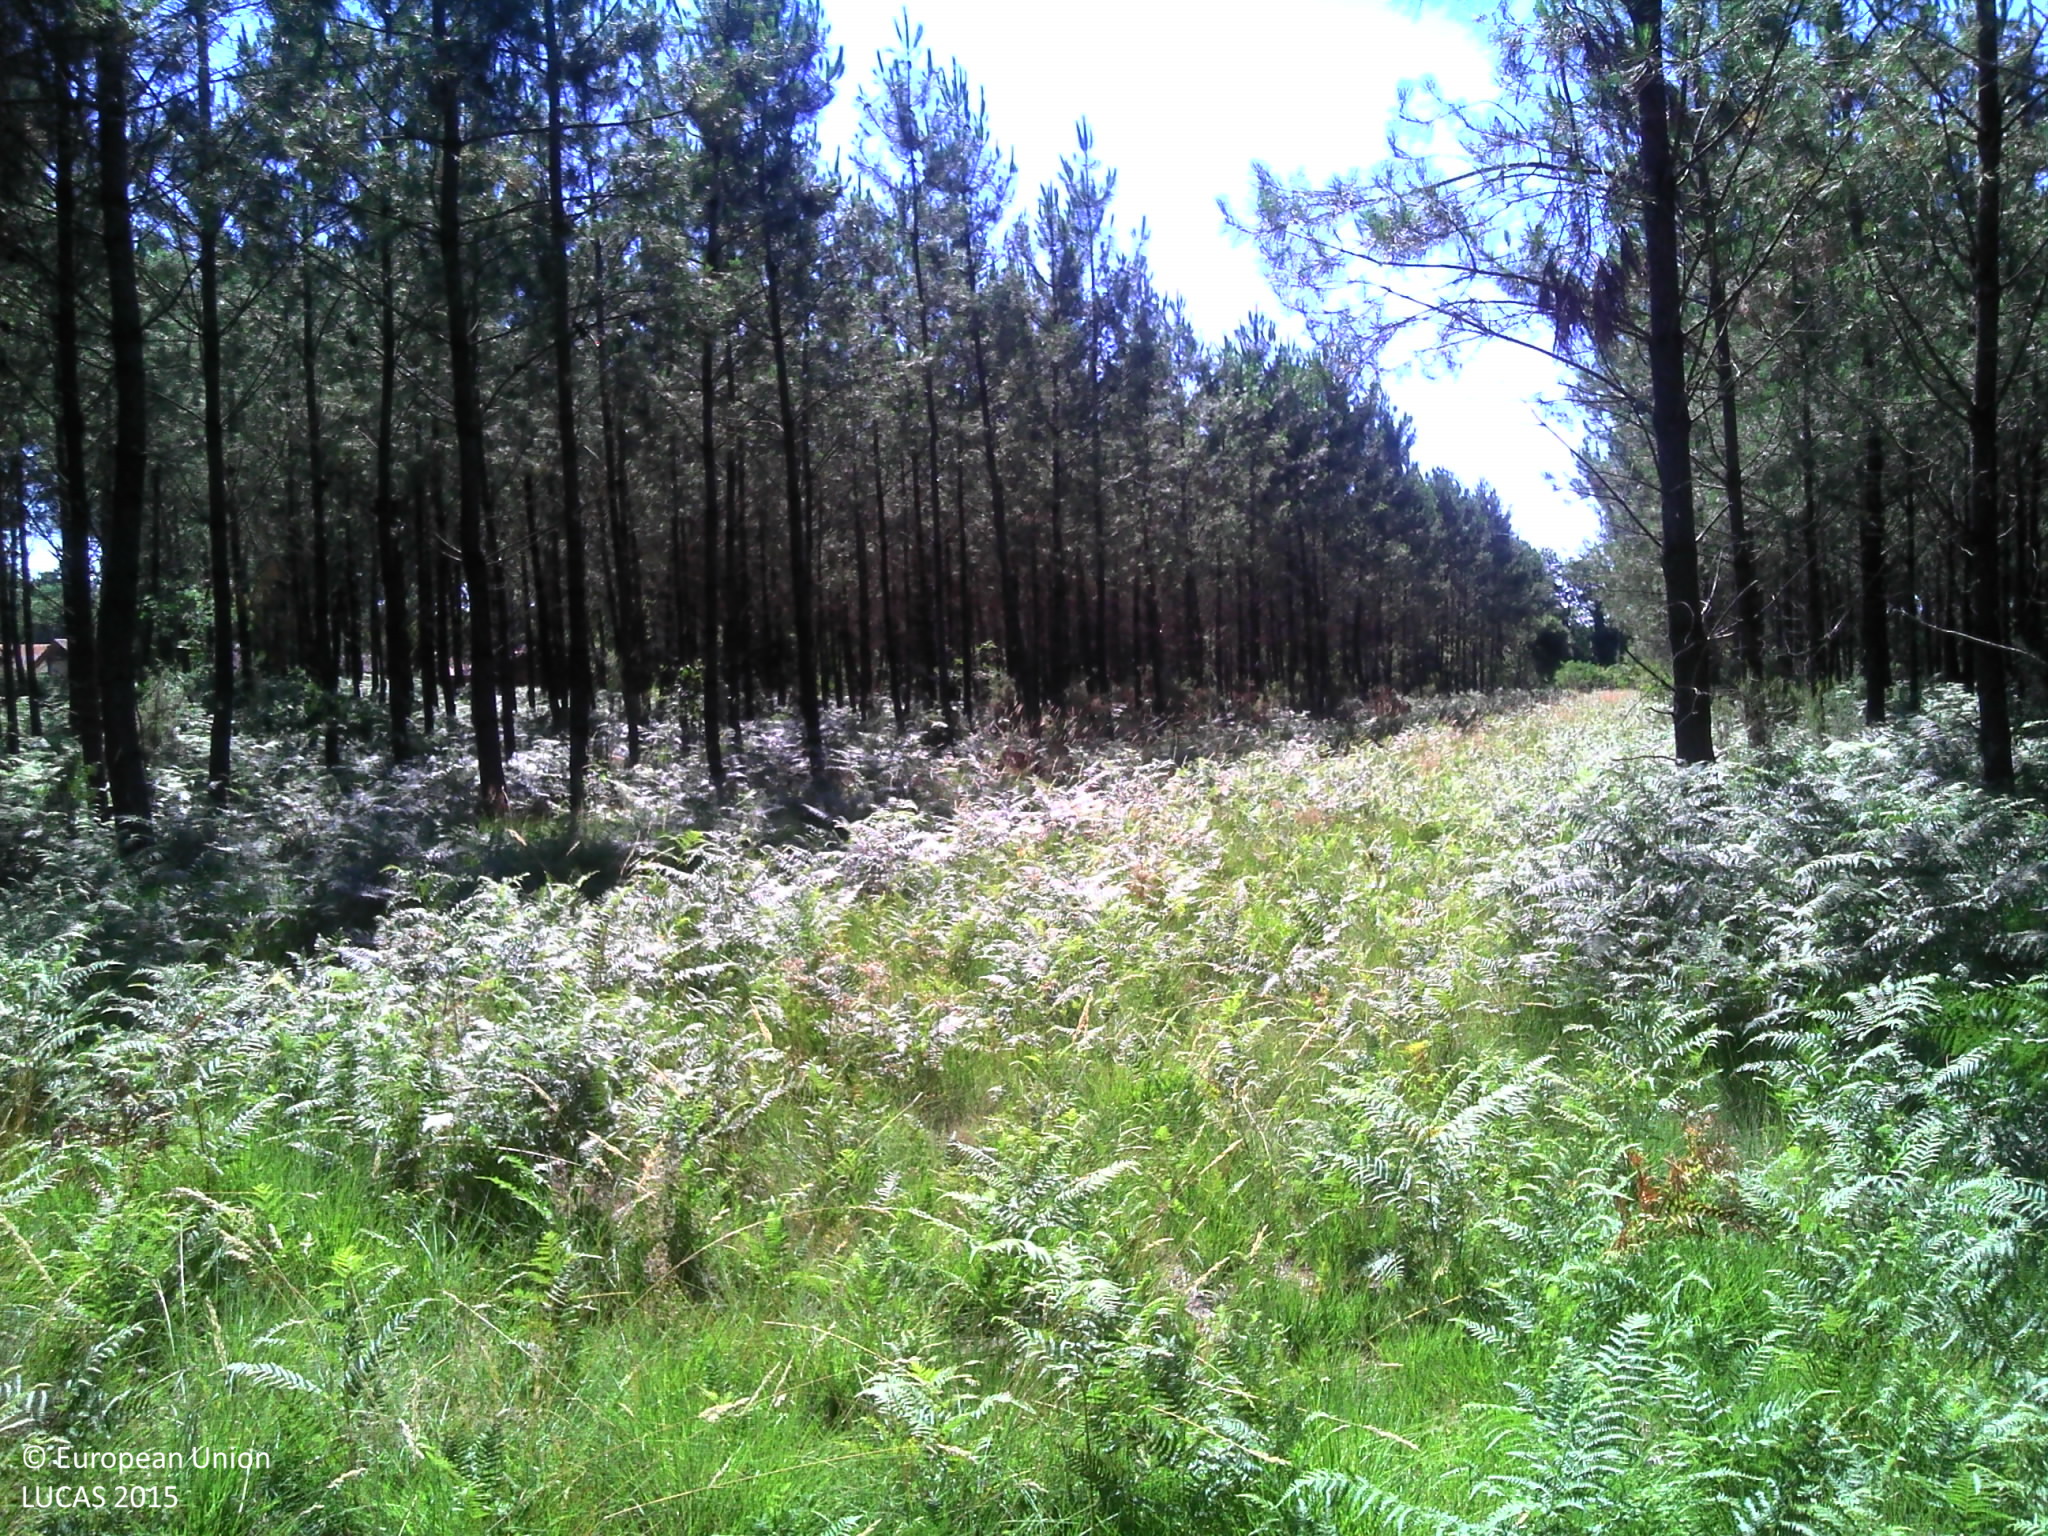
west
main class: Woodland
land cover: Pine dominated coniferous woodland
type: coniferous forest of the mediterranean region
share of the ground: > 75 %
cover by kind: coniferous forest trees 85 %, herbaceous plants 10 %, shrubs 5 %
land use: Forestry
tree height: > 5 m
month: July
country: FR
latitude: 43.9956
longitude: -0.5250
